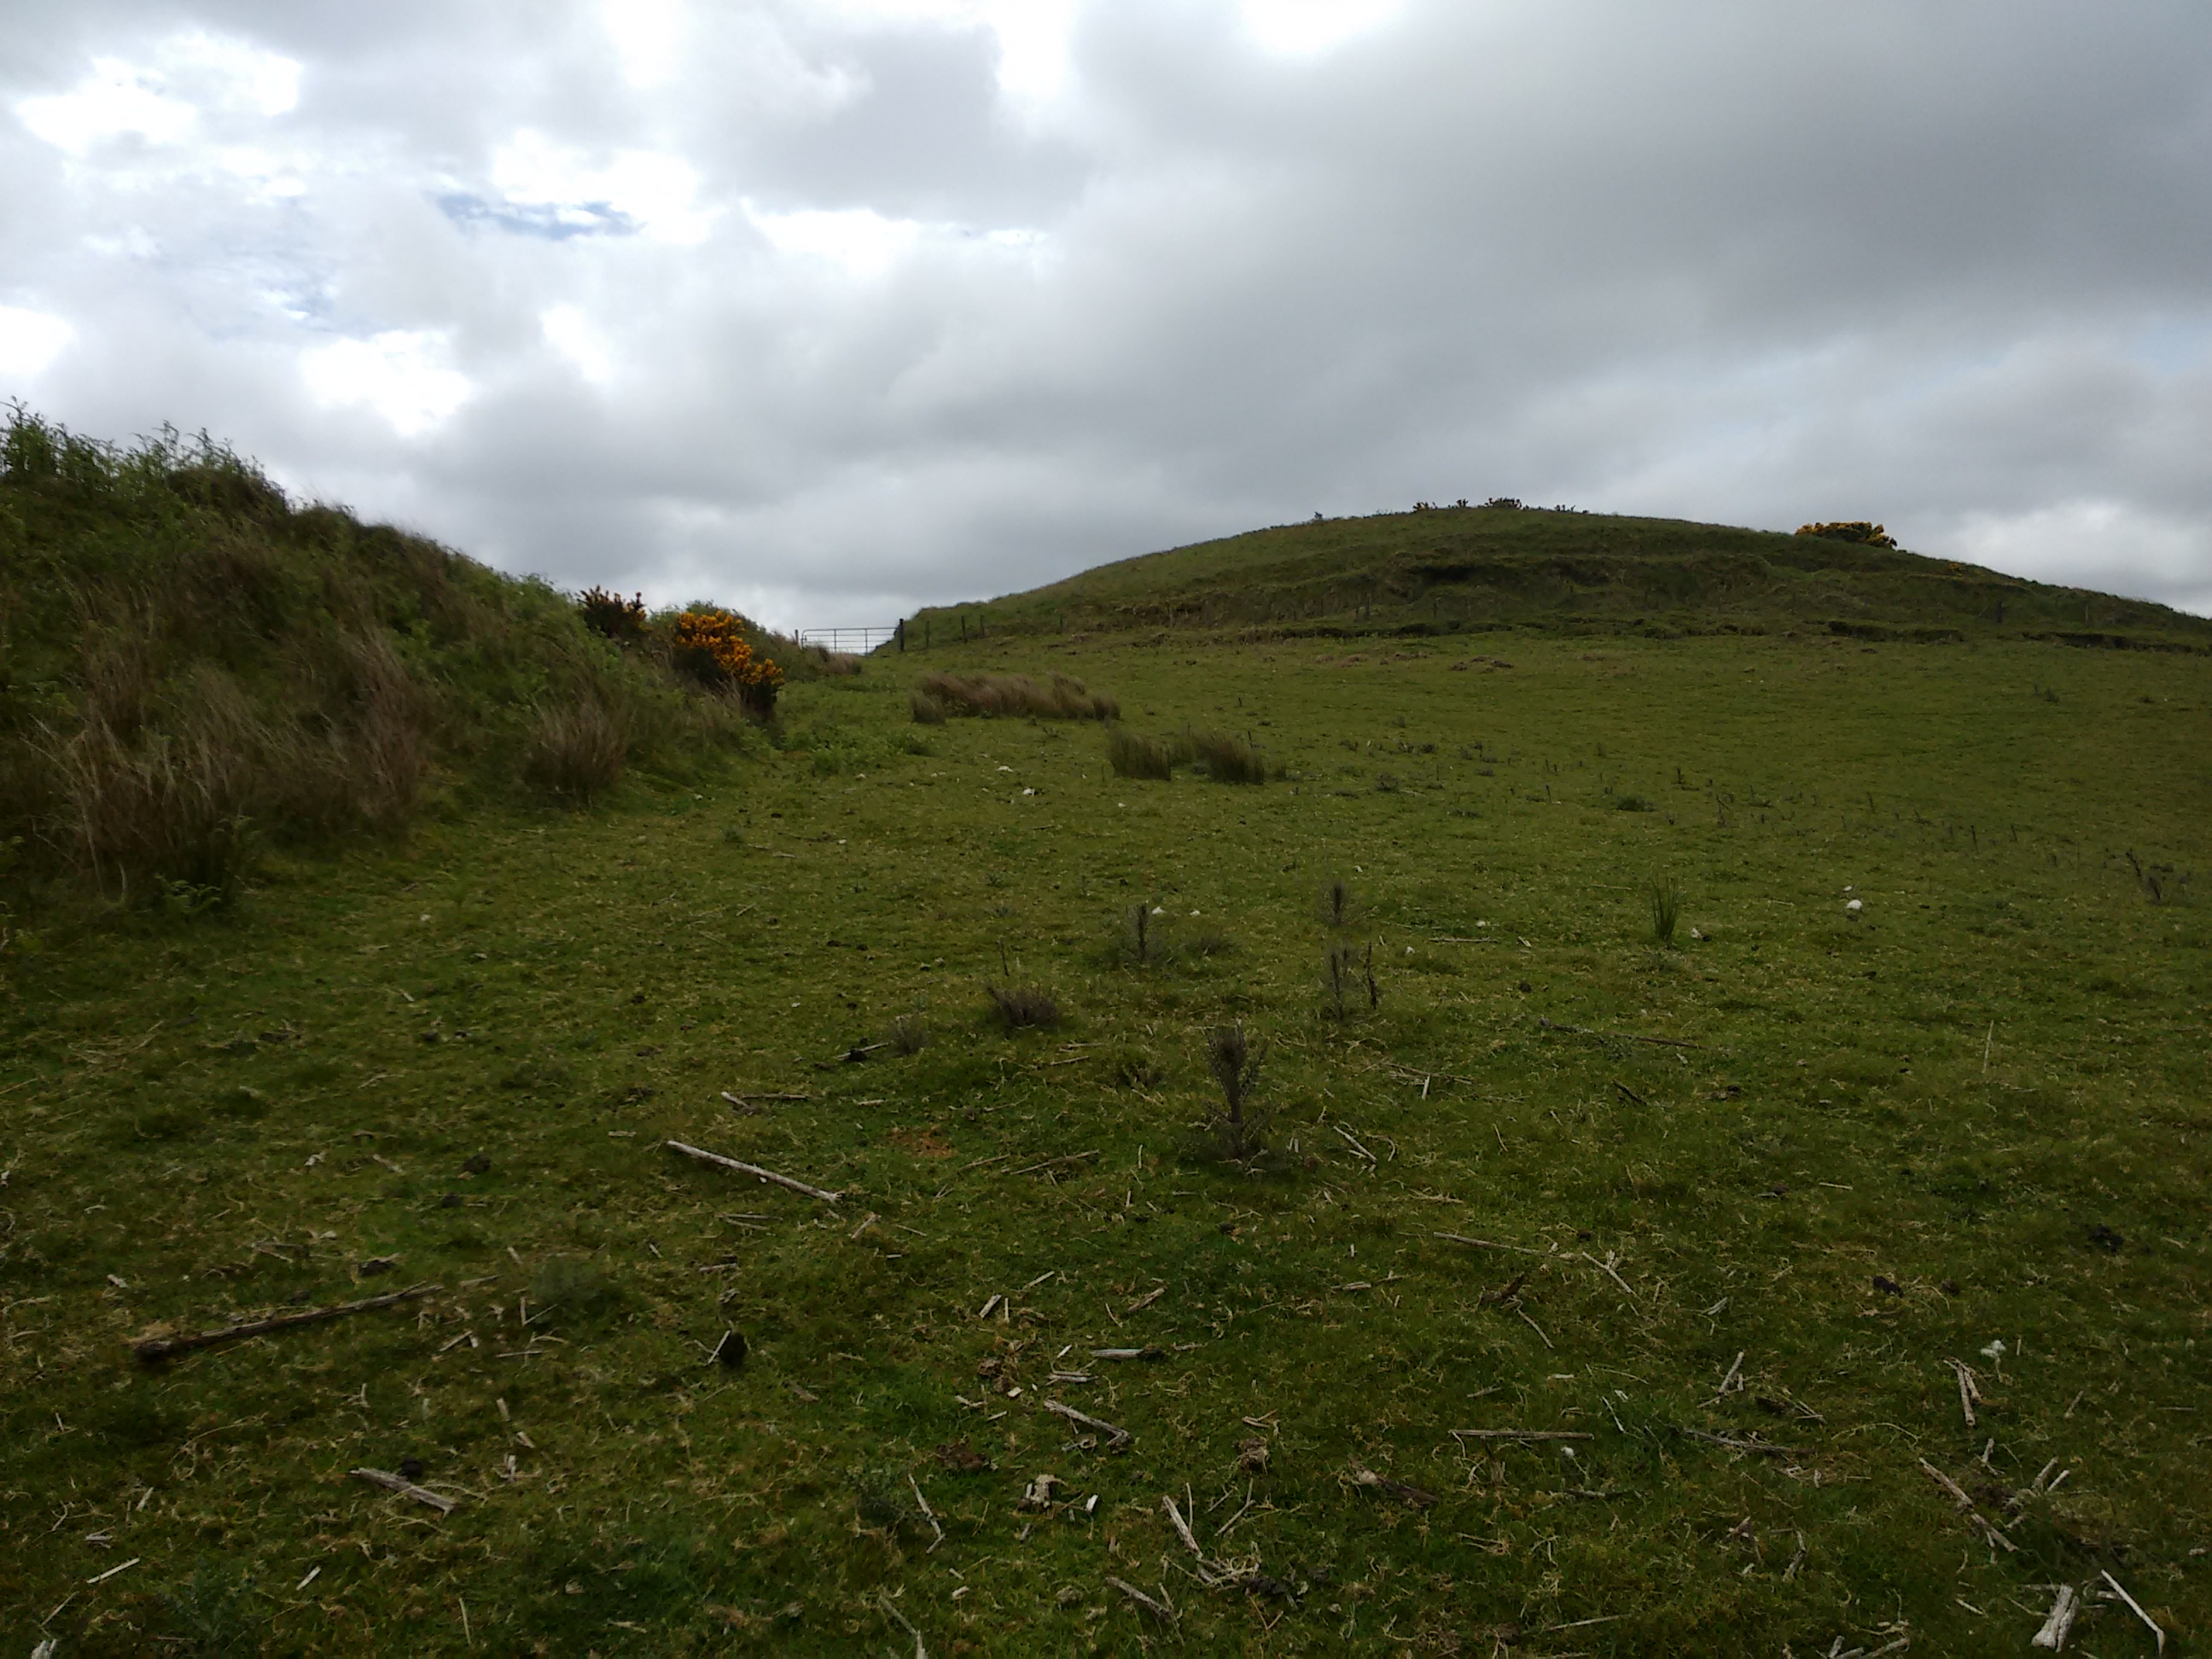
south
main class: Grassland
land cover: Grassland without tree/shrub cover
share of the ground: > 75 %
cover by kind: herbaceous plants 100 %
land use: Agriculture (excluding fallow land and kitchen gardens)
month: June
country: GB
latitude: 54.8808
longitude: -6.9550
